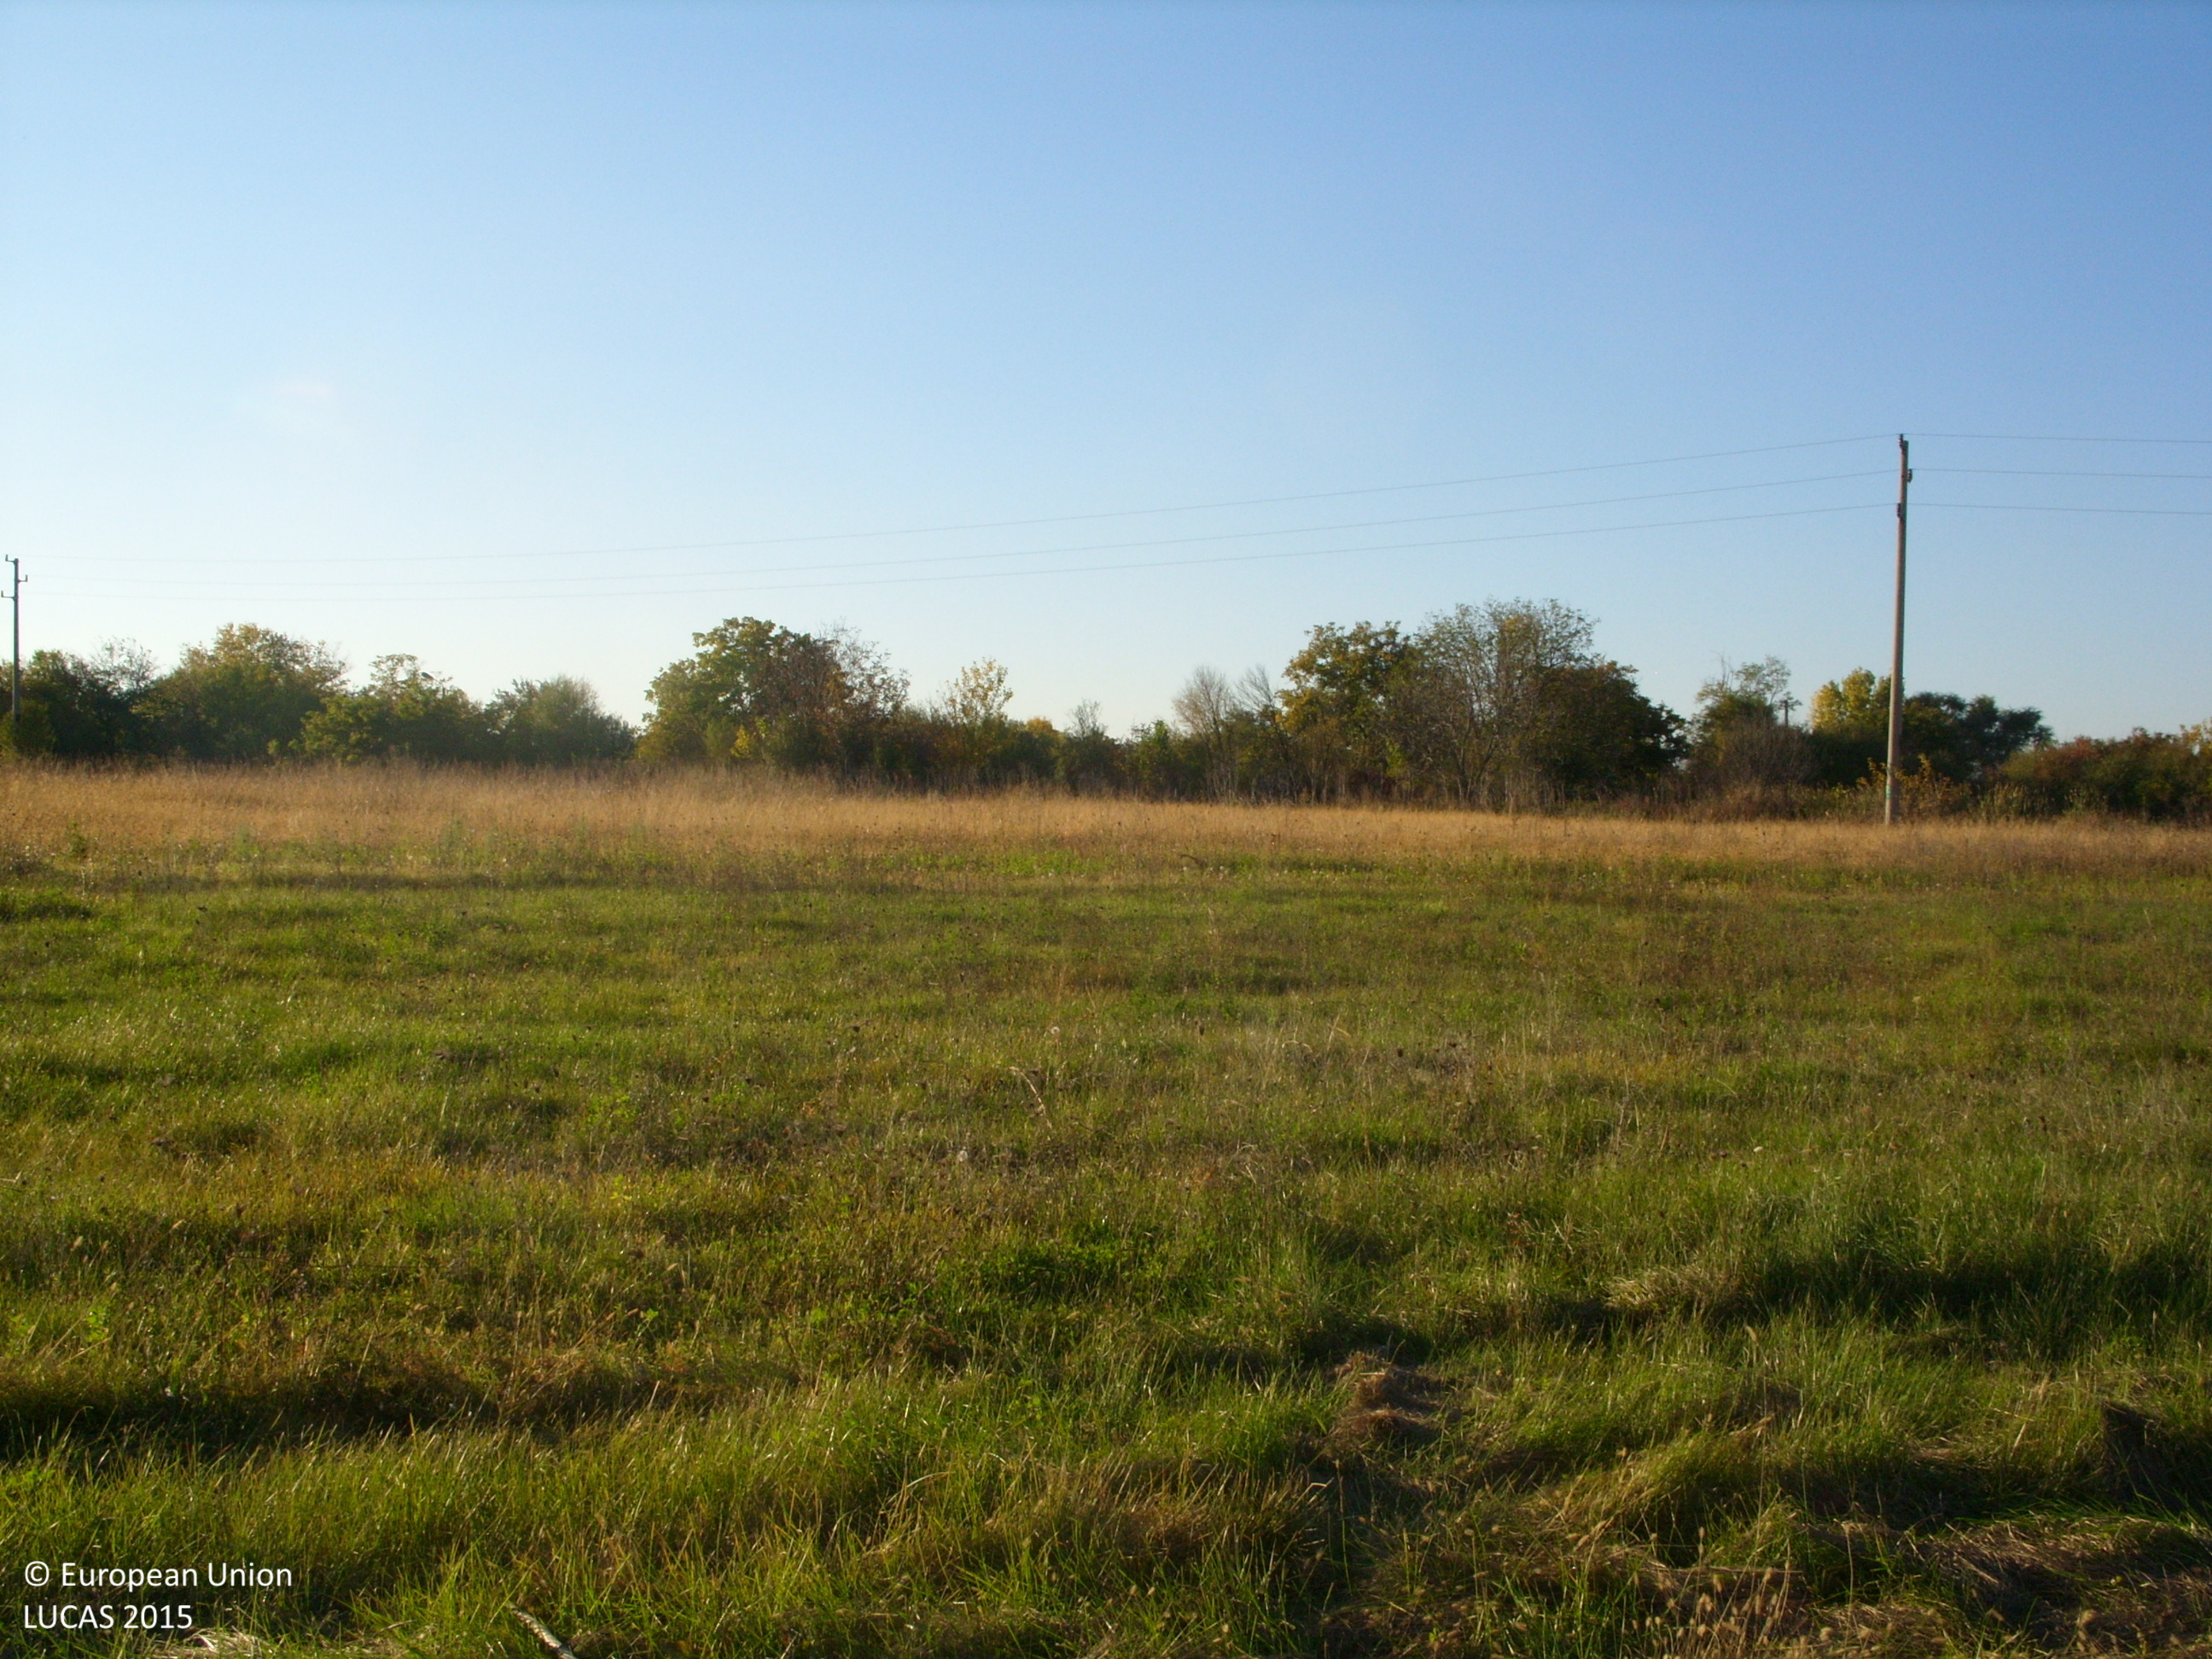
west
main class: Grassland
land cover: Grassland without tree/shrub cover
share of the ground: > 75 %
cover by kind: herbaceous plants 100 %
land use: Agriculture (excluding fallow land and kitchen gardens)
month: November
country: BG
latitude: 42.4110
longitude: 24.8692
